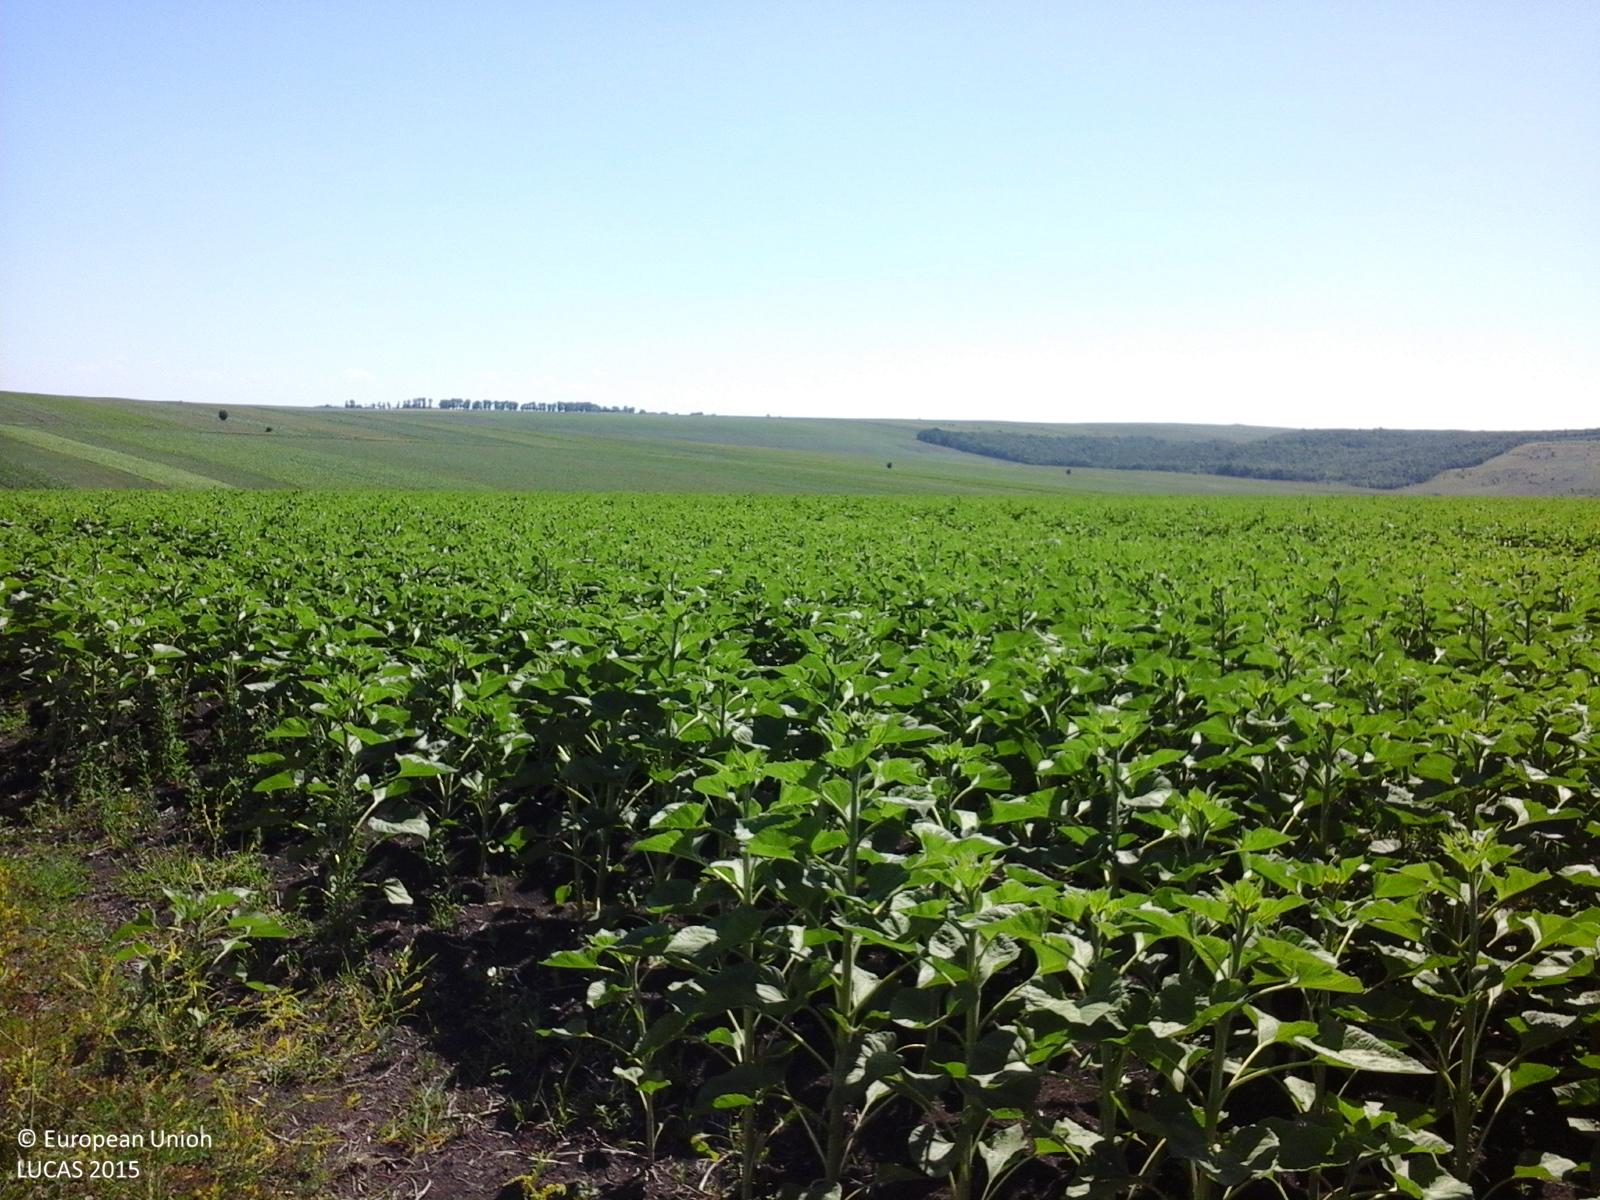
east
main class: Cropland
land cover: Sunflower
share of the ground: > 75 %
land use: Agriculture (excluding fallow land and kitchen gardens)
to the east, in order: Sunflower; Tracks; Maize; Soya
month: June
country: RO
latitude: 48.0899
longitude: 26.7339
